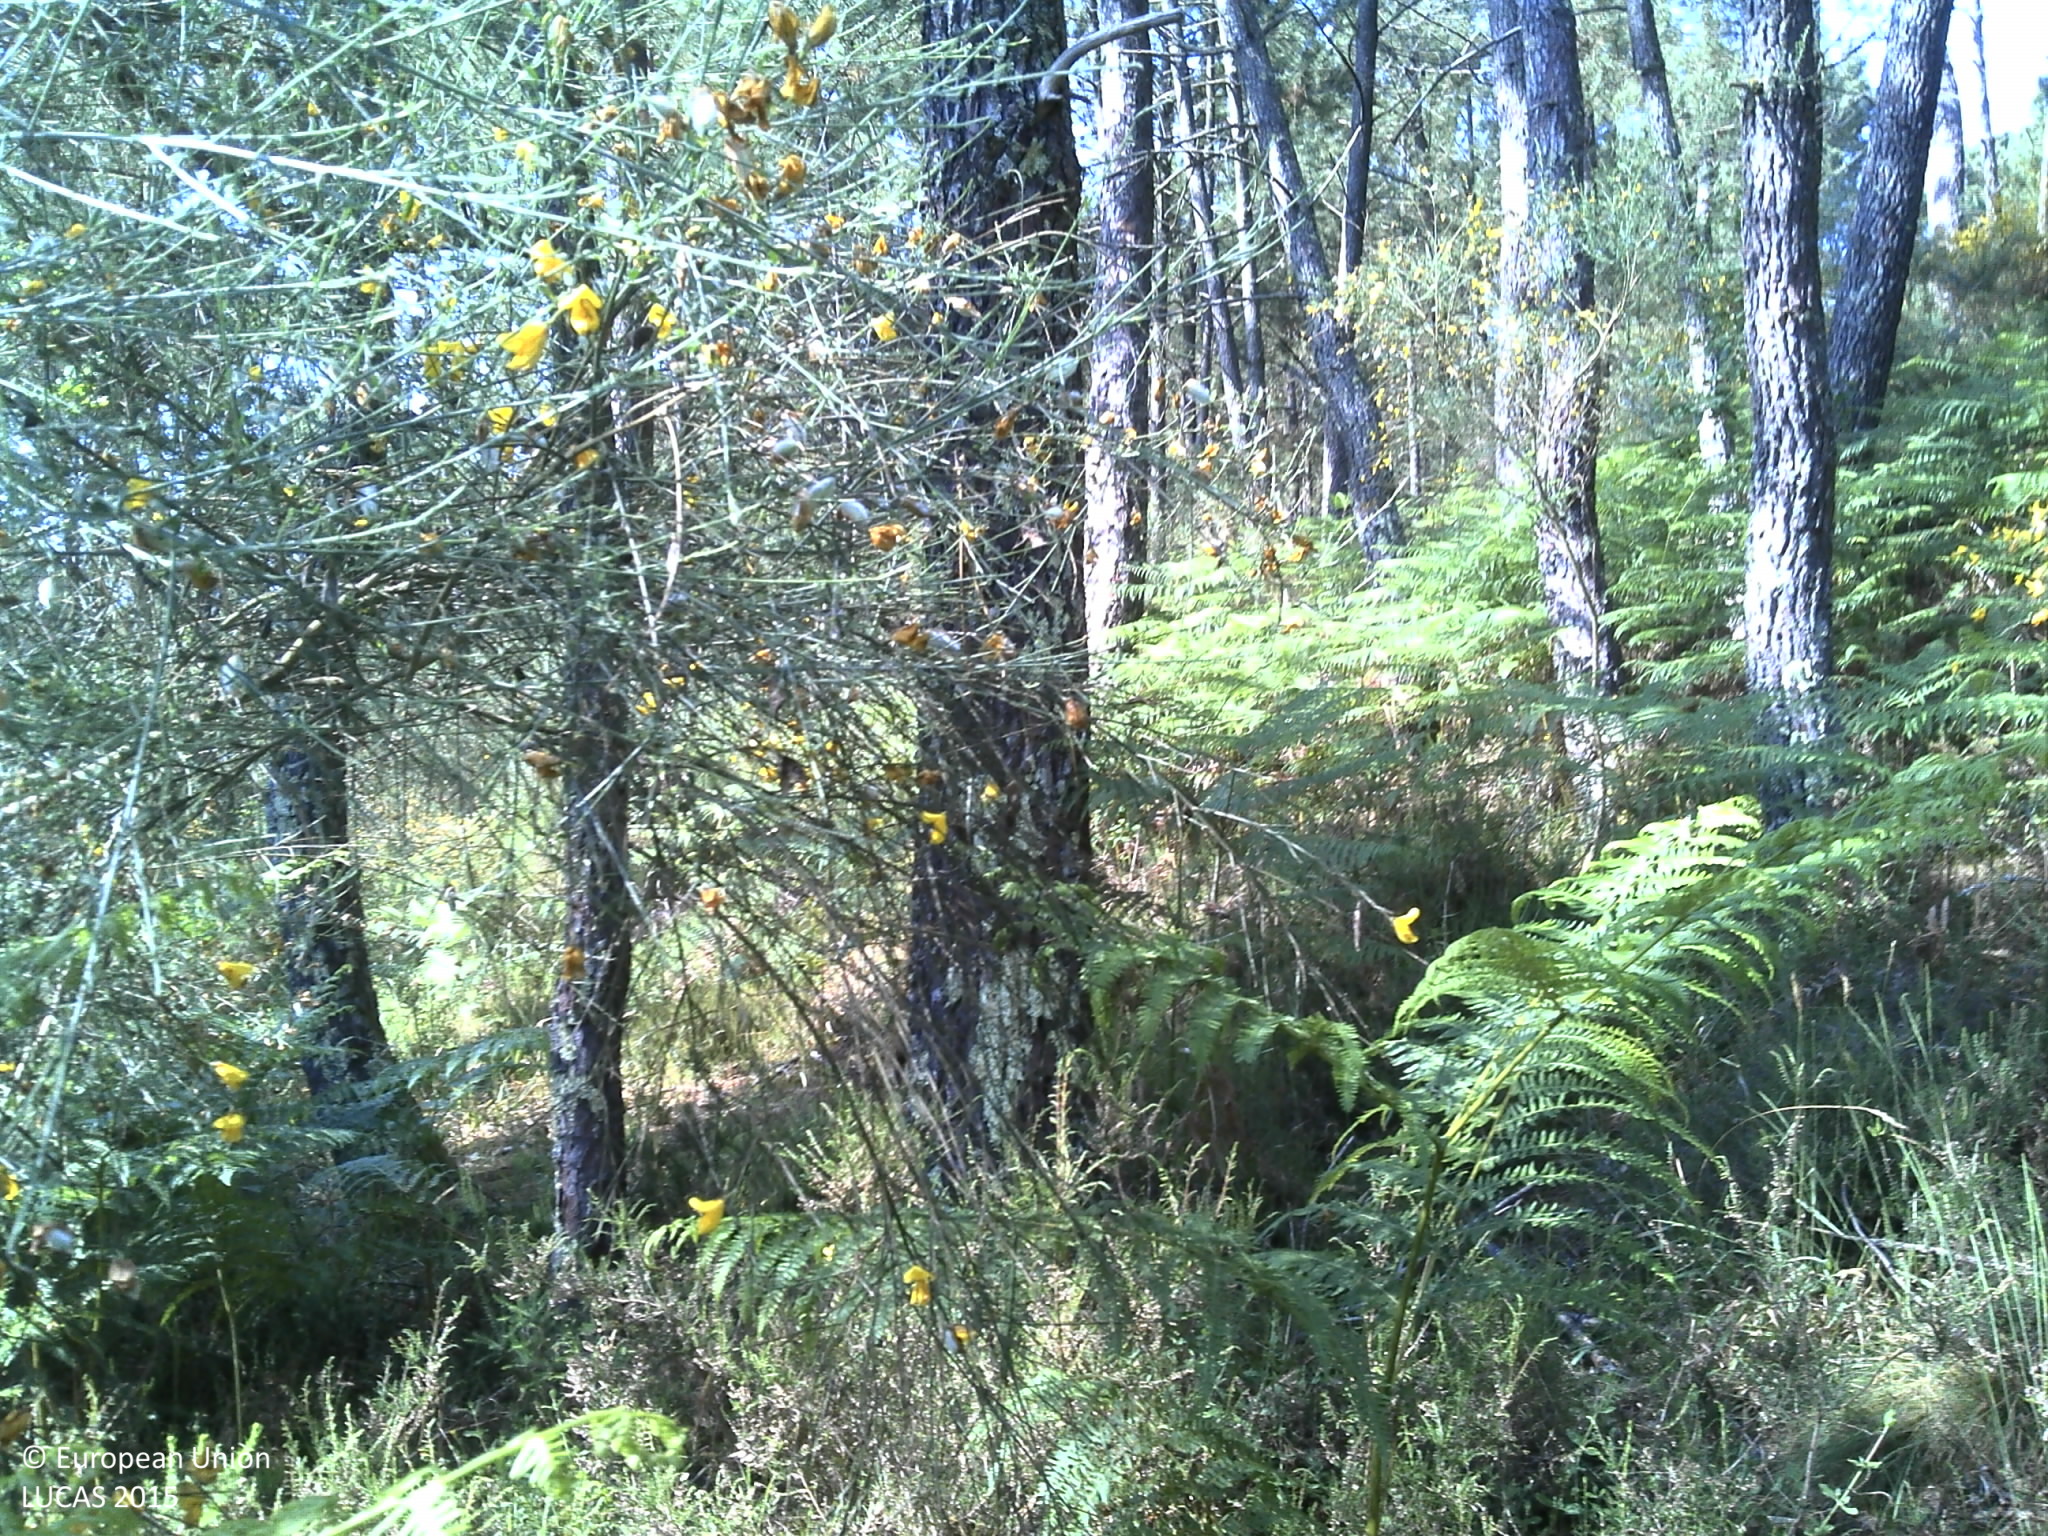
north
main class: Woodland
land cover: Pine dominated coniferous woodland
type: coniferous forest of the mediterranean region
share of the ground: > 75 %
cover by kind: coniferous forest trees 80 %, shrubs 20 %
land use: Forestry
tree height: > 5 m
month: June
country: PT
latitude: 42.0646
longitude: -8.2731
